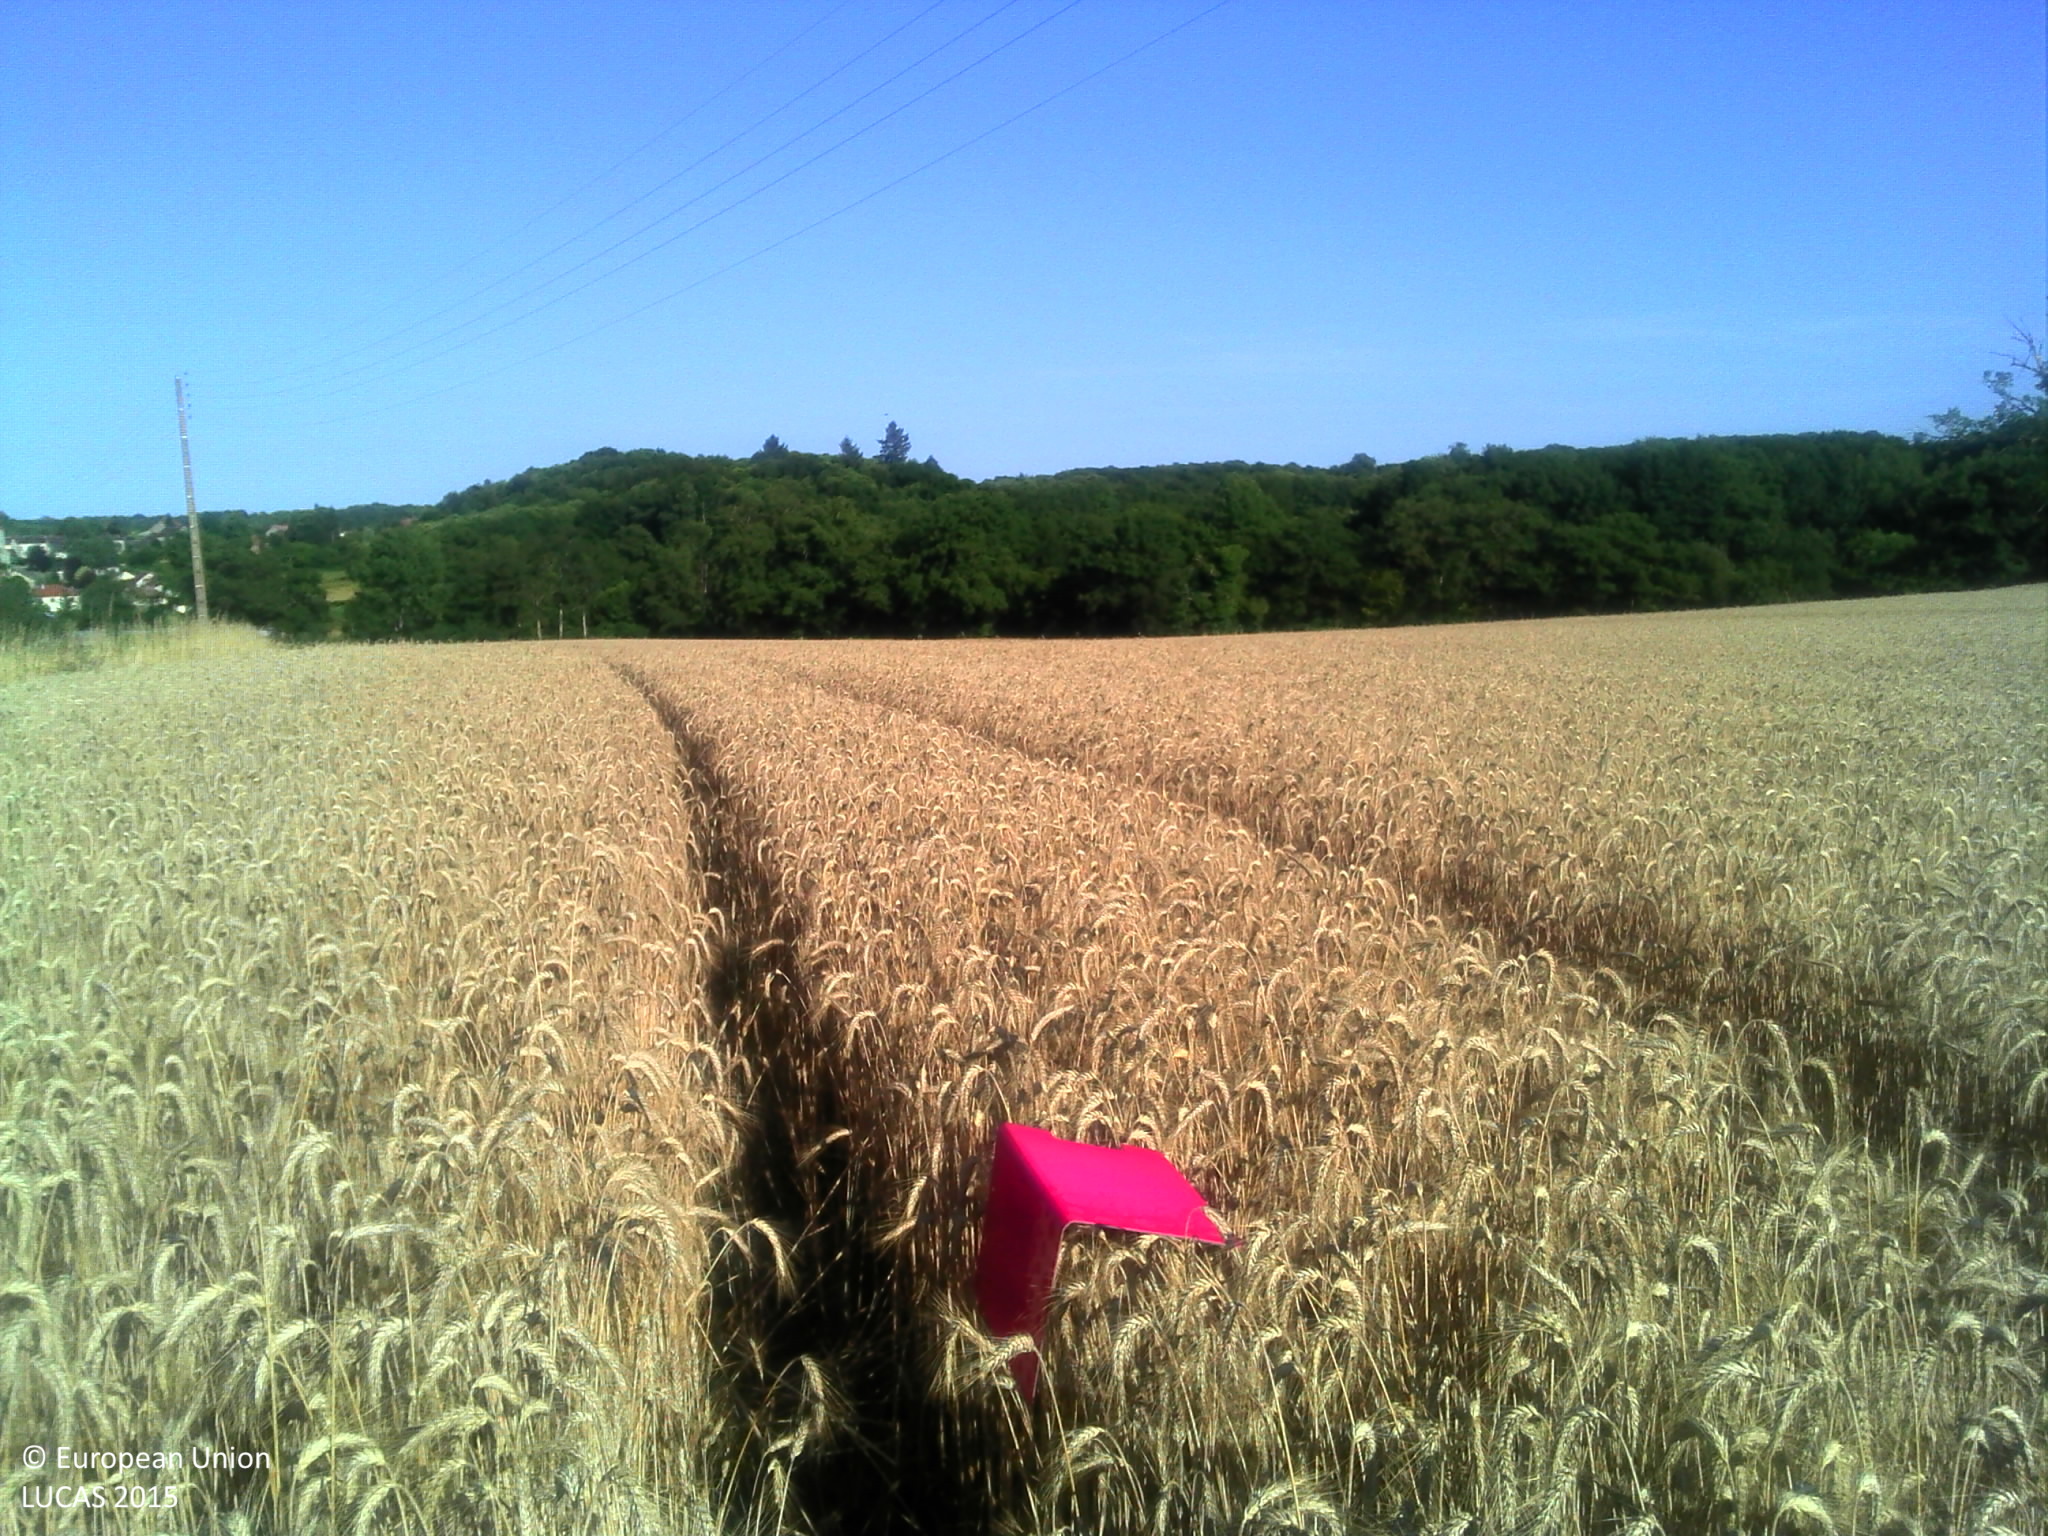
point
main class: Cropland
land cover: Common wheat
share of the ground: > 75 %
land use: Agriculture (excluding fallow land and kitchen gardens)
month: July
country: FR
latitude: 46.2357
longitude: 1.5752
